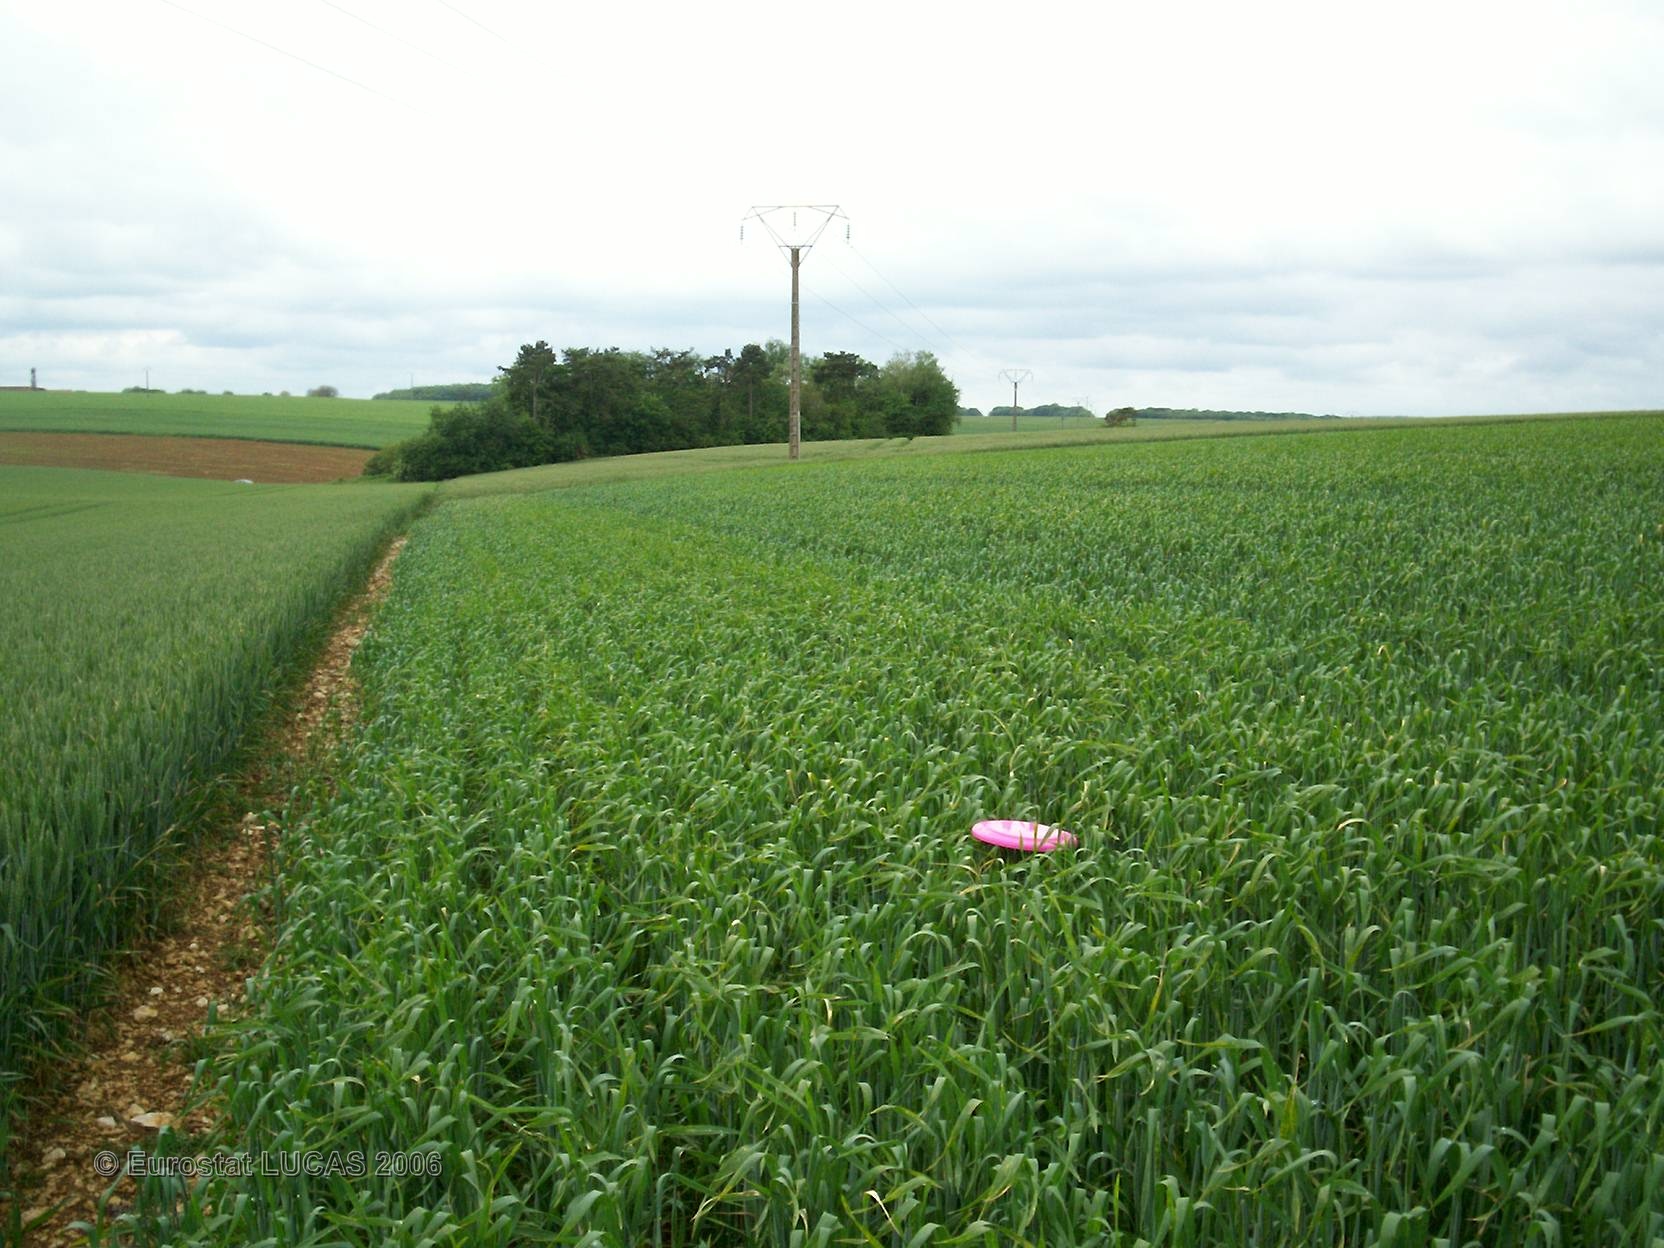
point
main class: Cropland
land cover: Common wheat
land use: Agriculture (excluding fallow land and kitchen gardens)
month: May
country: FR
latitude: 48.2507
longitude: 4.5432
